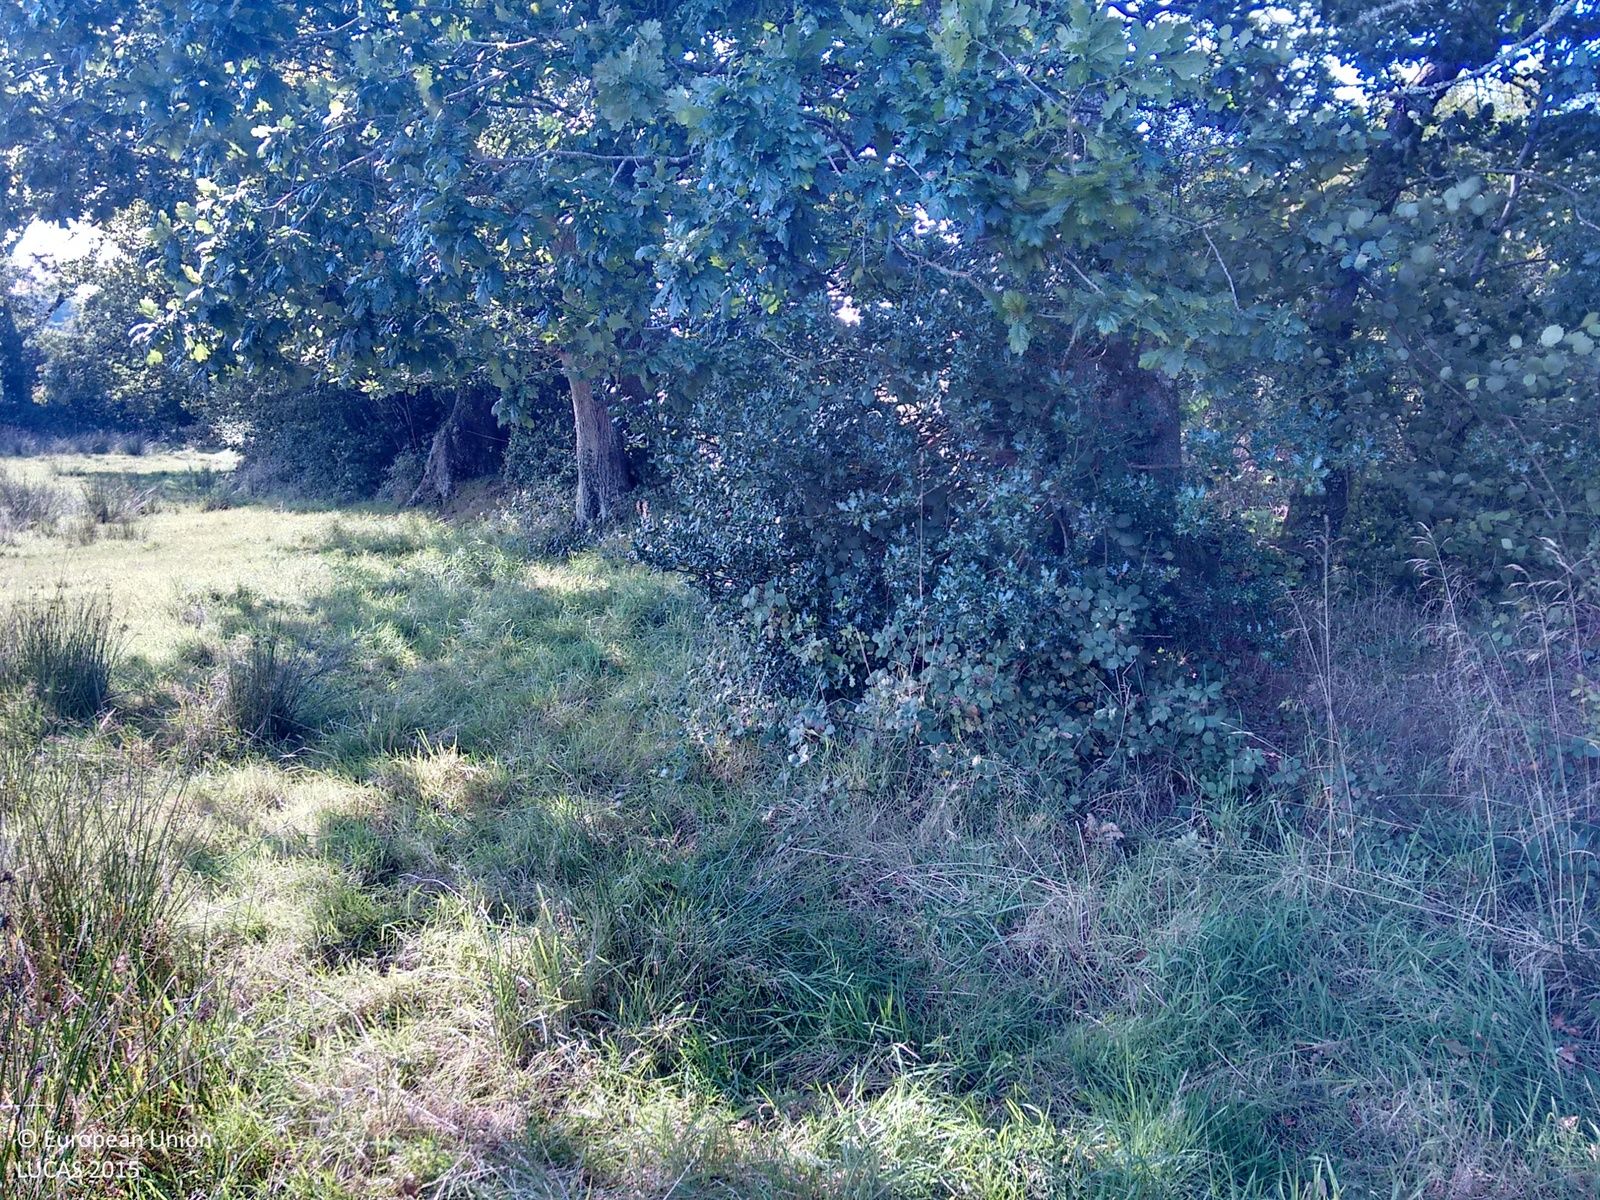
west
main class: Grassland
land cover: Grassland without tree/shrub cover
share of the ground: > 75 %
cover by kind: herbaceous plants 100 %
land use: Agriculture (excluding fallow land and kitchen gardens)
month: September
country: GB
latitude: 50.8667
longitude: -4.2951
